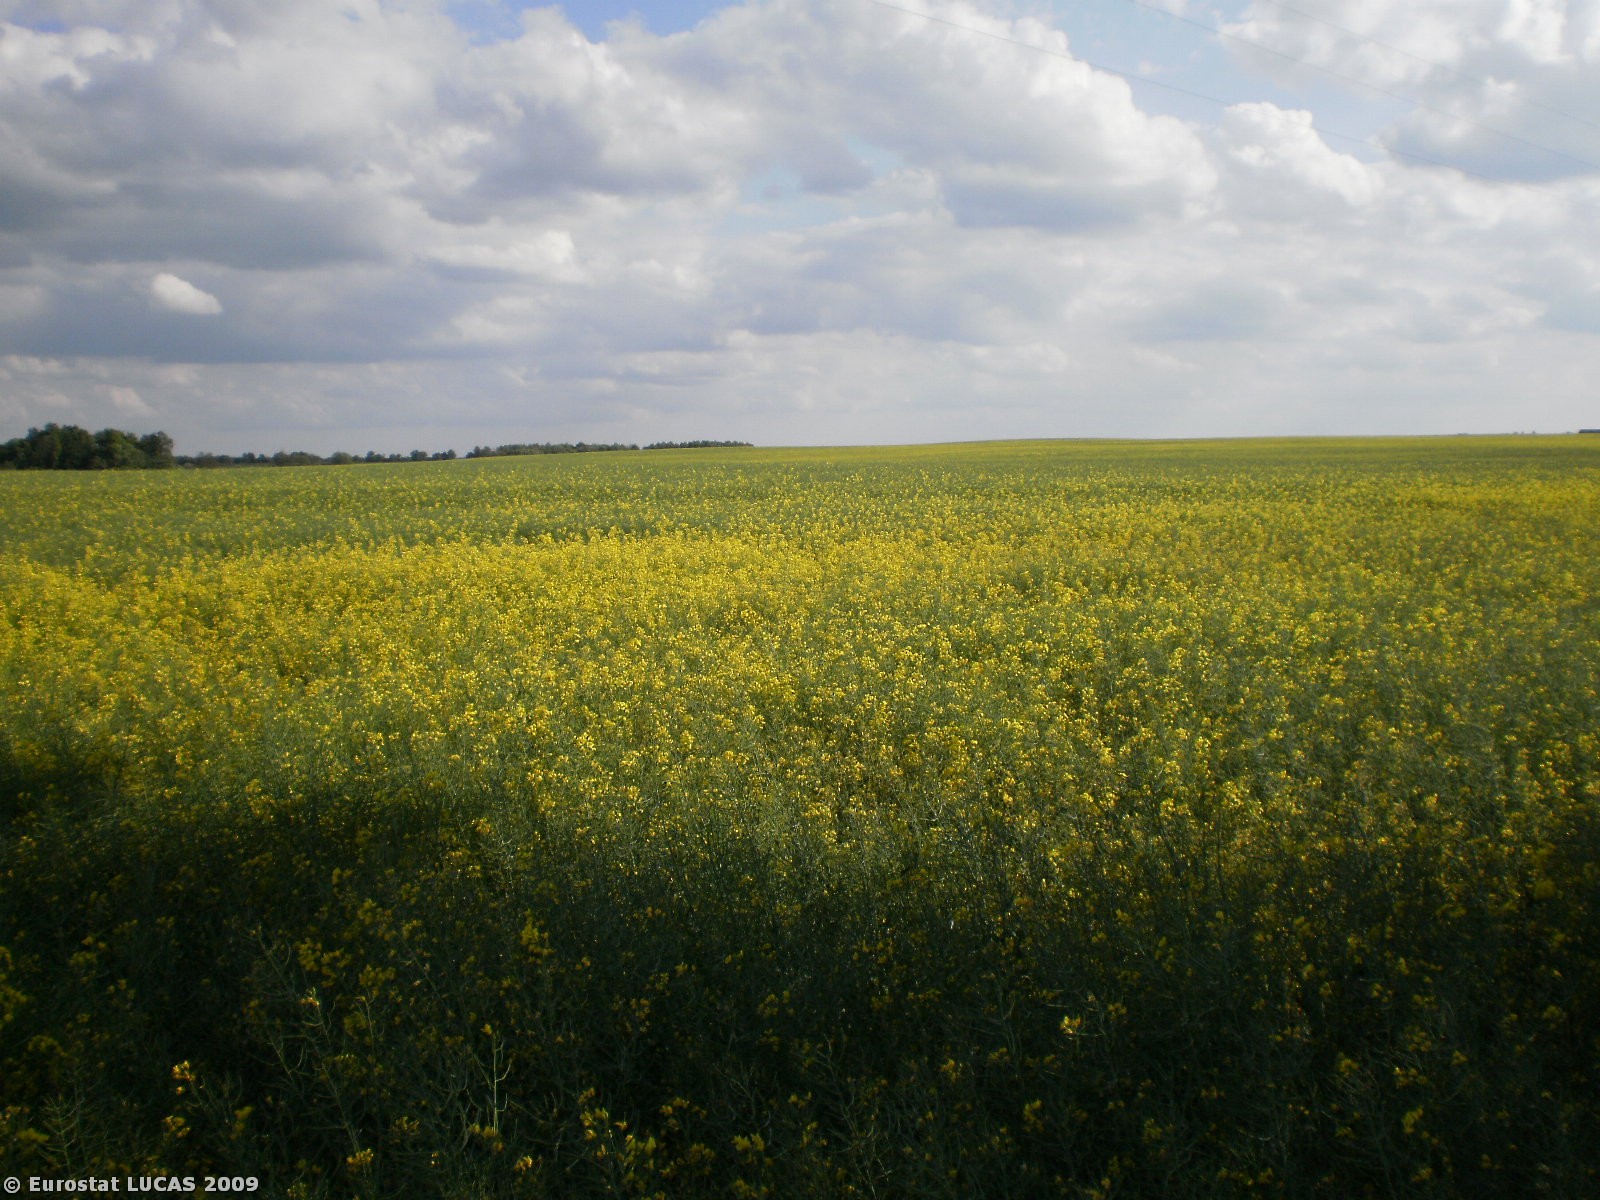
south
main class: Cropland
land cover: Rape and turnip rape
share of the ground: > 75 %
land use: Agriculture (excluding fallow land and kitchen gardens)
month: May
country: PL
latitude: 53.4649
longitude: 17.6799
